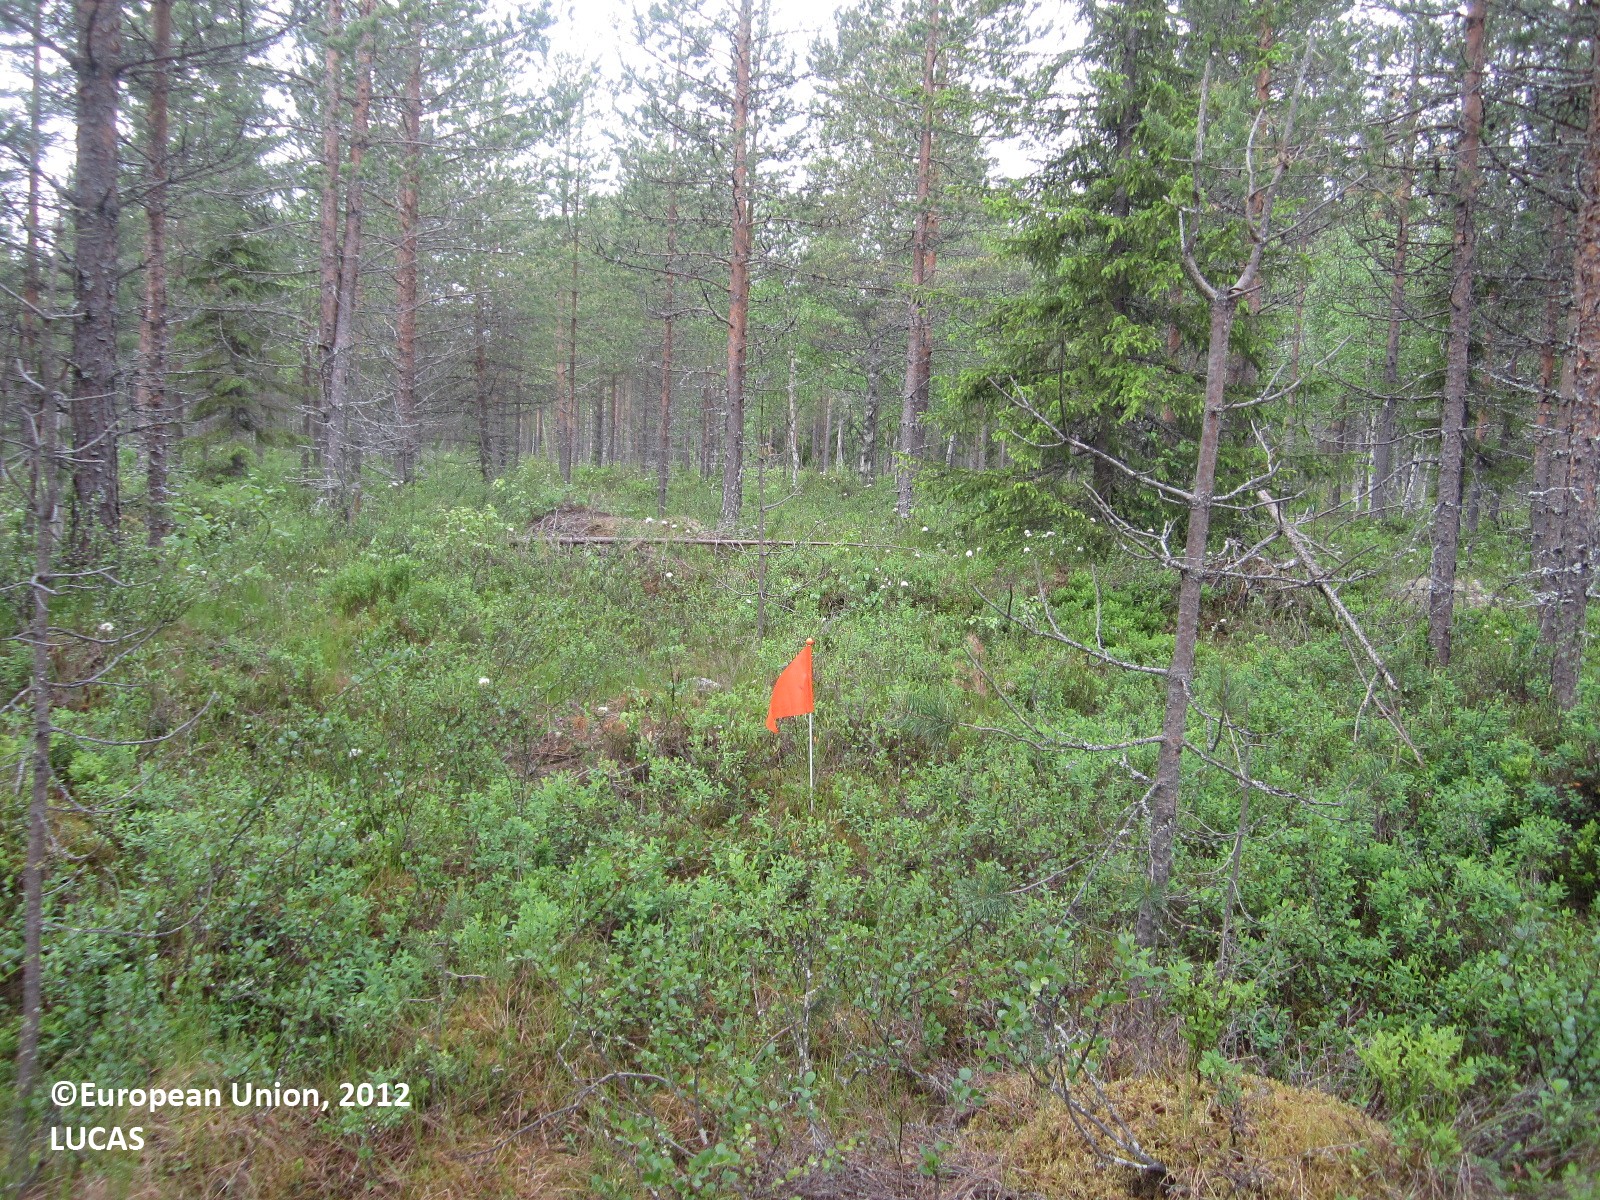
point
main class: Woodland
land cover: Pine dominated coniferous woodland
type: boreal forest
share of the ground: 50 - 75 %
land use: Forestry
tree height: > 5 m
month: June
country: FI
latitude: 64.7455
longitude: 29.7787
